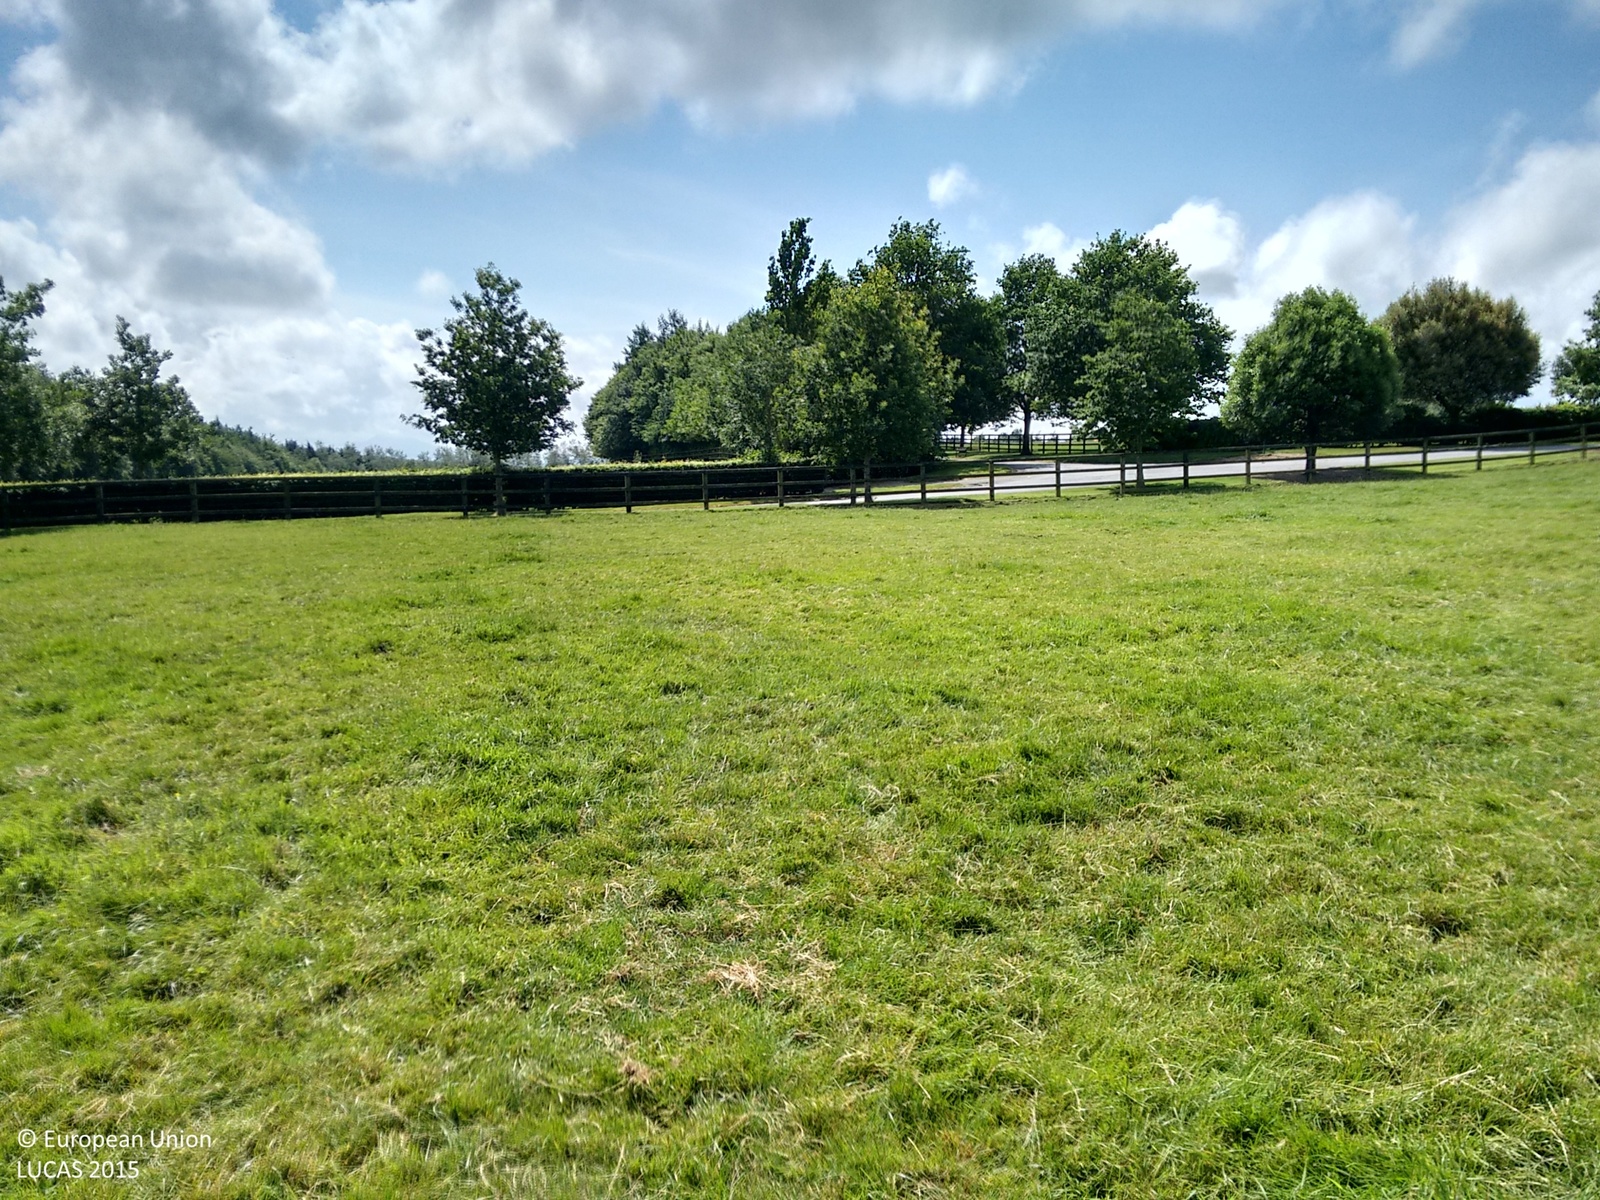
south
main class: Grassland
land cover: Grassland without tree/shrub cover
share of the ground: > 75 %
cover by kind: herbaceous plants 100 %
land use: Agriculture (excluding fallow land and kitchen gardens)
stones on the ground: < 10 %
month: July
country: IE
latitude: 52.4915
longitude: -7.6764
